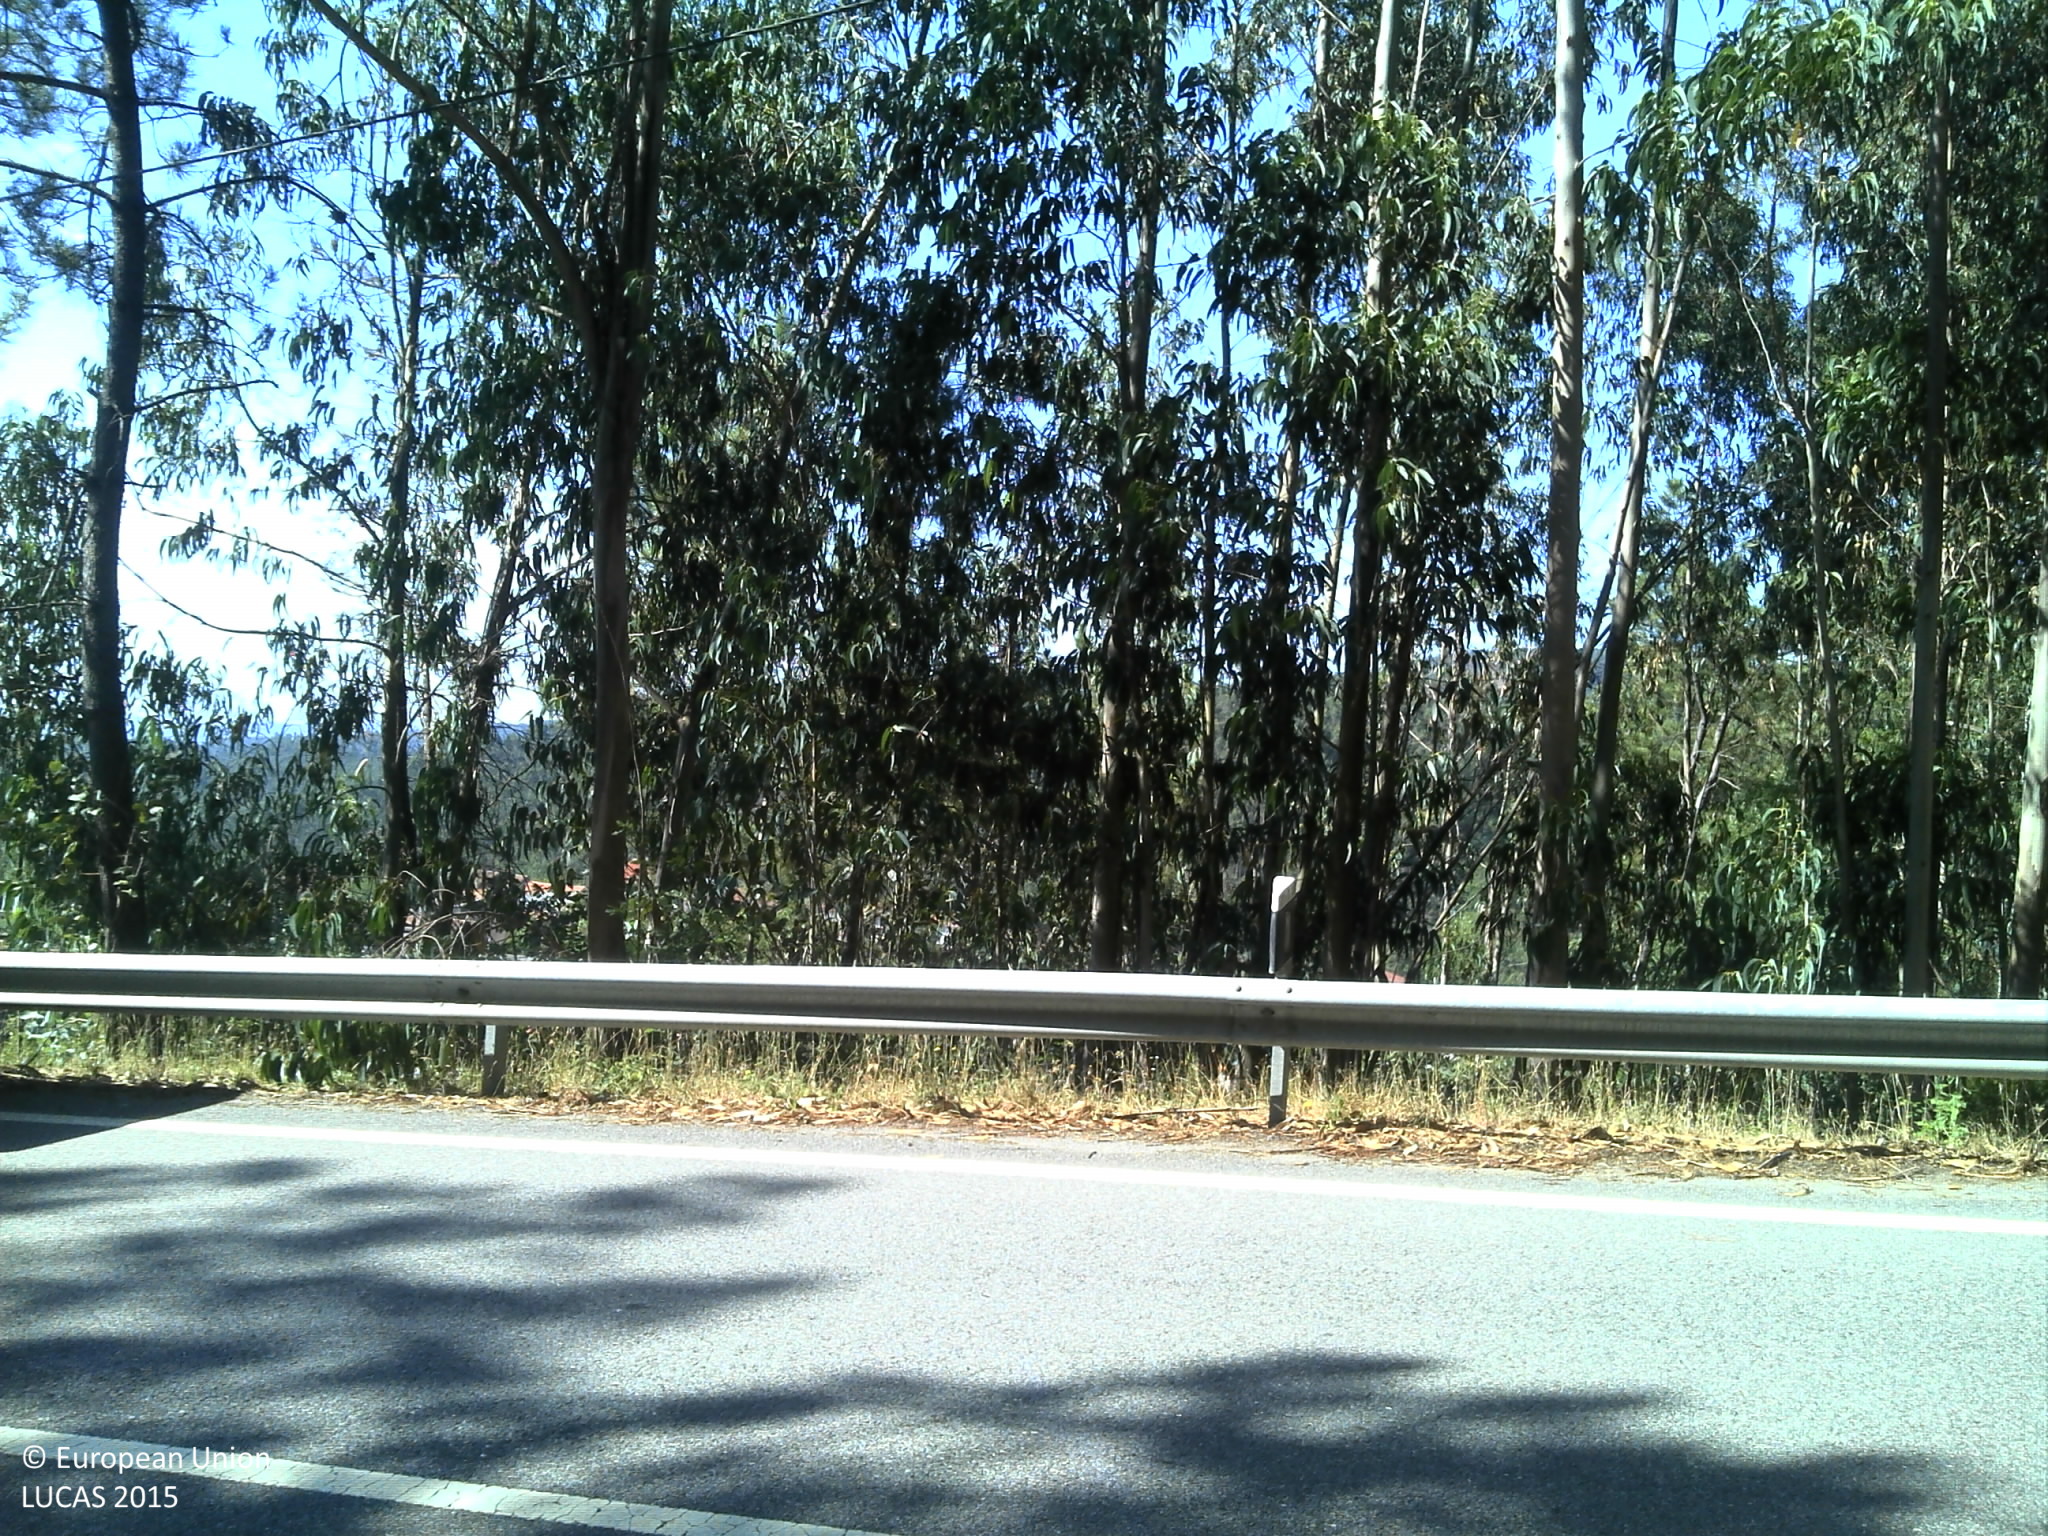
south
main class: Woodland
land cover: Broadleaved woodland
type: exotic forest
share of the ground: 50 - 75 %
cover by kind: broadleaved forest trees 70 %, shrubs 20 %, unconsolidated bare surface 10 %
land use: Forestry
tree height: > 5 m
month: July
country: PT
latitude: 40.4696
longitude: -8.3071
